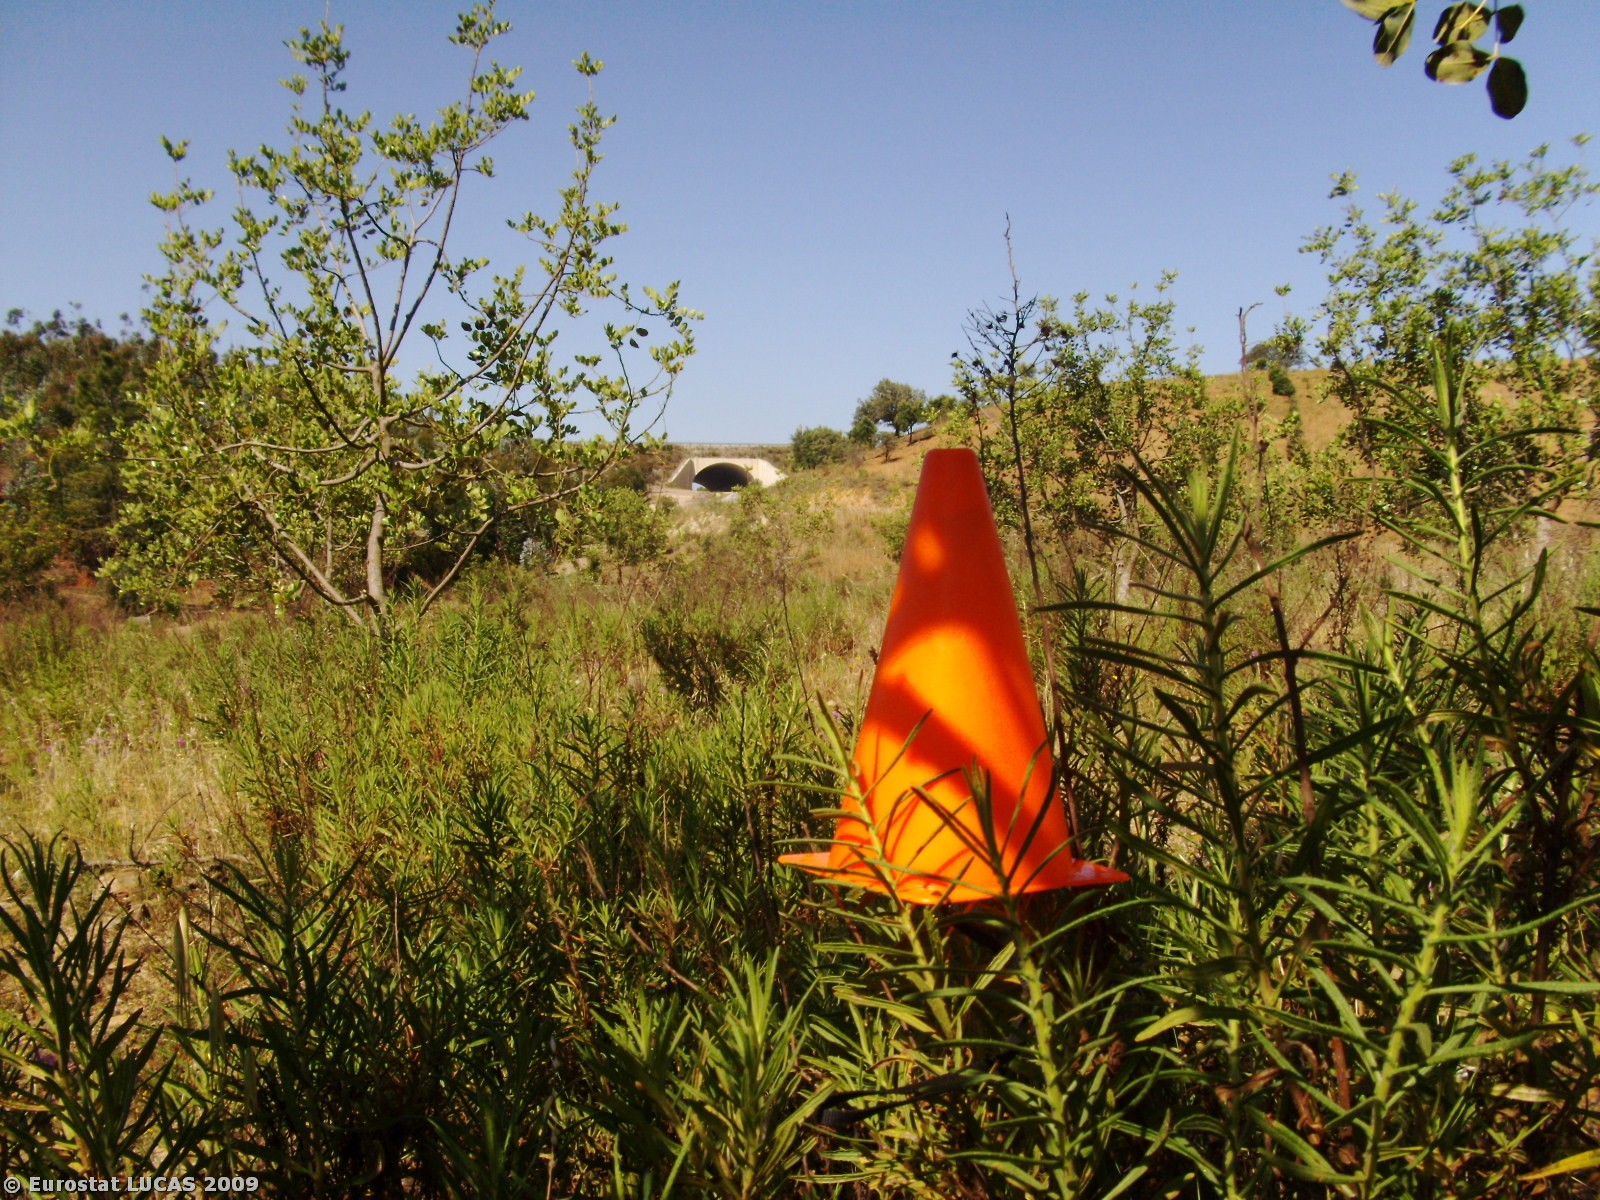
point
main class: Cropland
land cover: Permanent industrial crops
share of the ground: 10 - 25 %
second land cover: Spontaneously vegetated surfaces
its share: 25 - 50 %
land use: Agriculture (excluding fallow land and kitchen gardens)
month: May
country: PT
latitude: 37.2789
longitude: -8.2589
